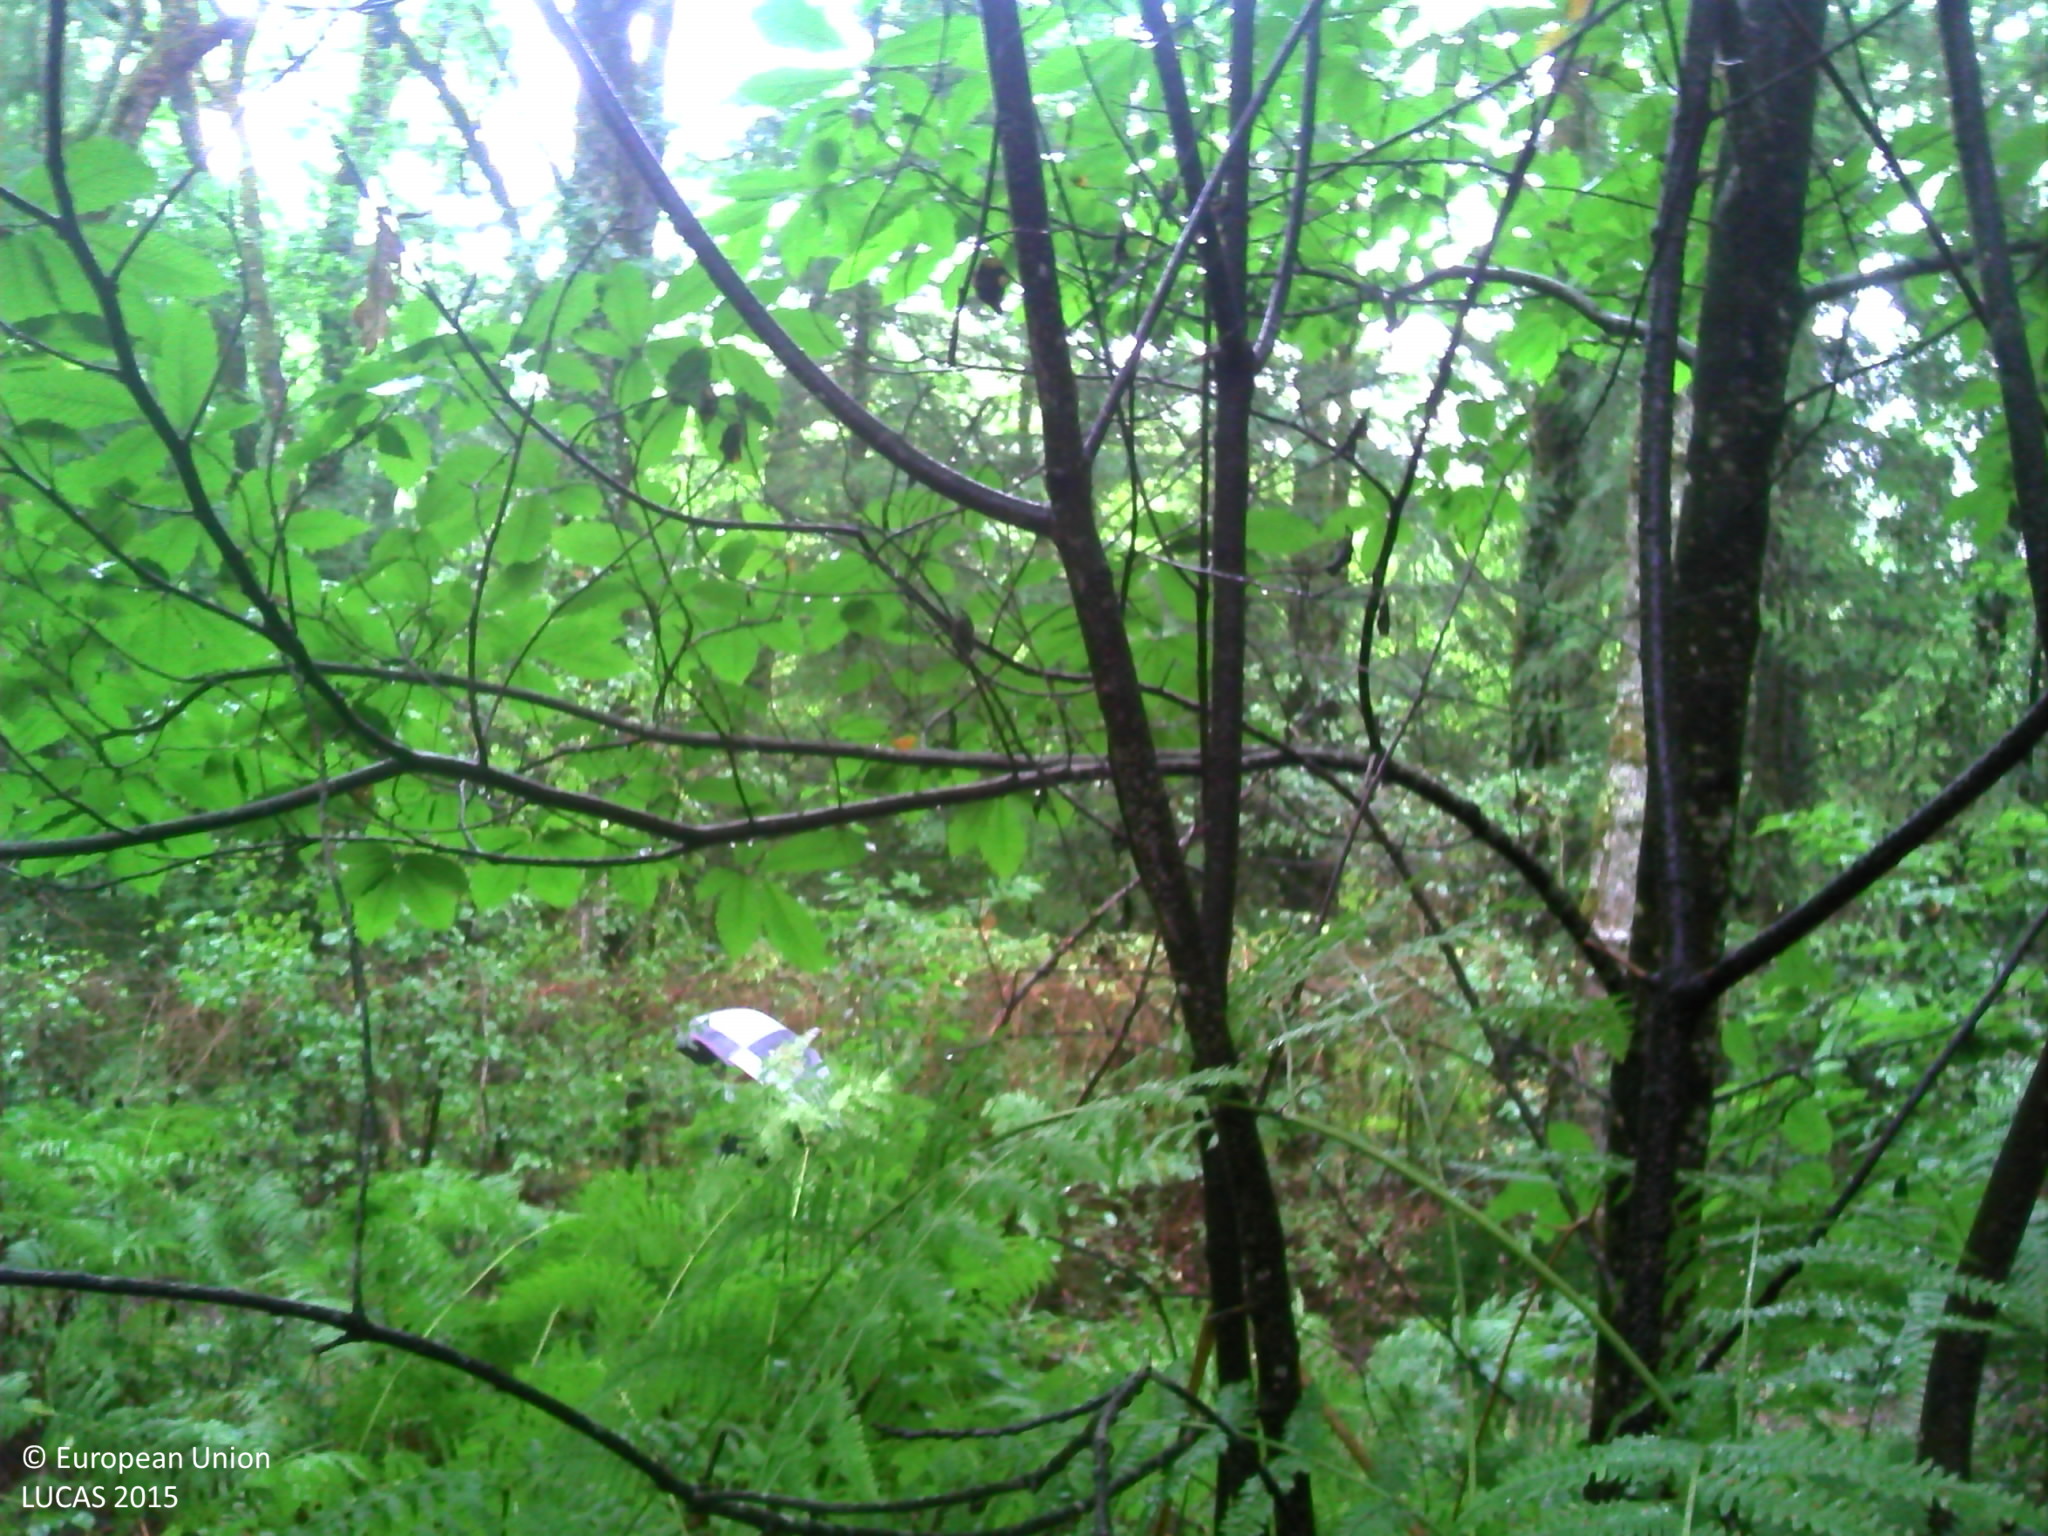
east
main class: Woodland
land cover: Broadleaved woodland
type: thermophilous deciduous forest
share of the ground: > 75 %
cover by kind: broadleaved forest trees 100 %
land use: Residential
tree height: > 5 m
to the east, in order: Broadleaved woodland; Fences; Broadleaved woodland; Tracks; Spruce dominated mixed woodland; Spontaneously vegetated surfaces; Electric lines; Spontaneously vegetated surfaces; Inland marshes; Broadleaved woodland; Spruce dominated coniferous woodland
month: August
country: FR
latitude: 46.0099
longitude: 1.2467
